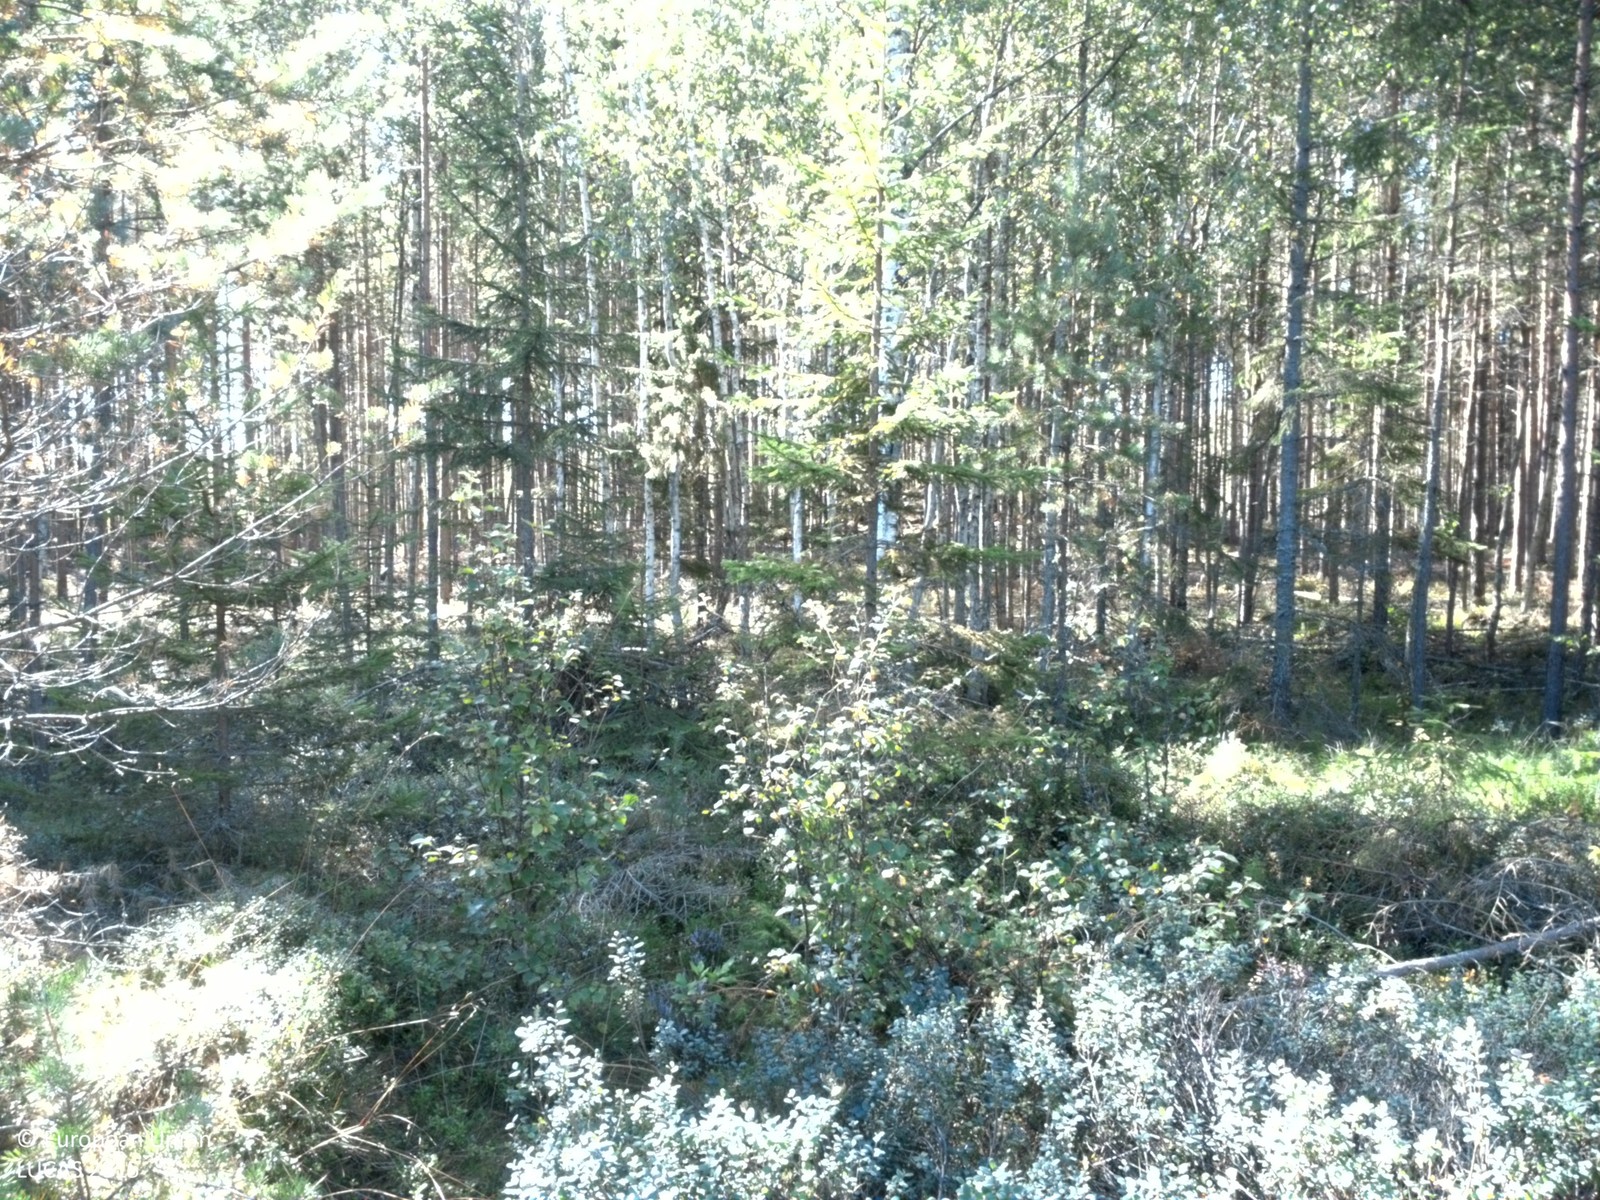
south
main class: Woodland
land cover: Pine dominated coniferous woodland
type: boreal forest
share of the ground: 50 - 75 %
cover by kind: coniferous forest trees 65 %, shrubs 30 %, herbaceous plants 5 %
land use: Forestry
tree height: < 5 m
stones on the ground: < 10 %
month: August
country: SE
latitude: 59.6227
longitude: 15.9302
